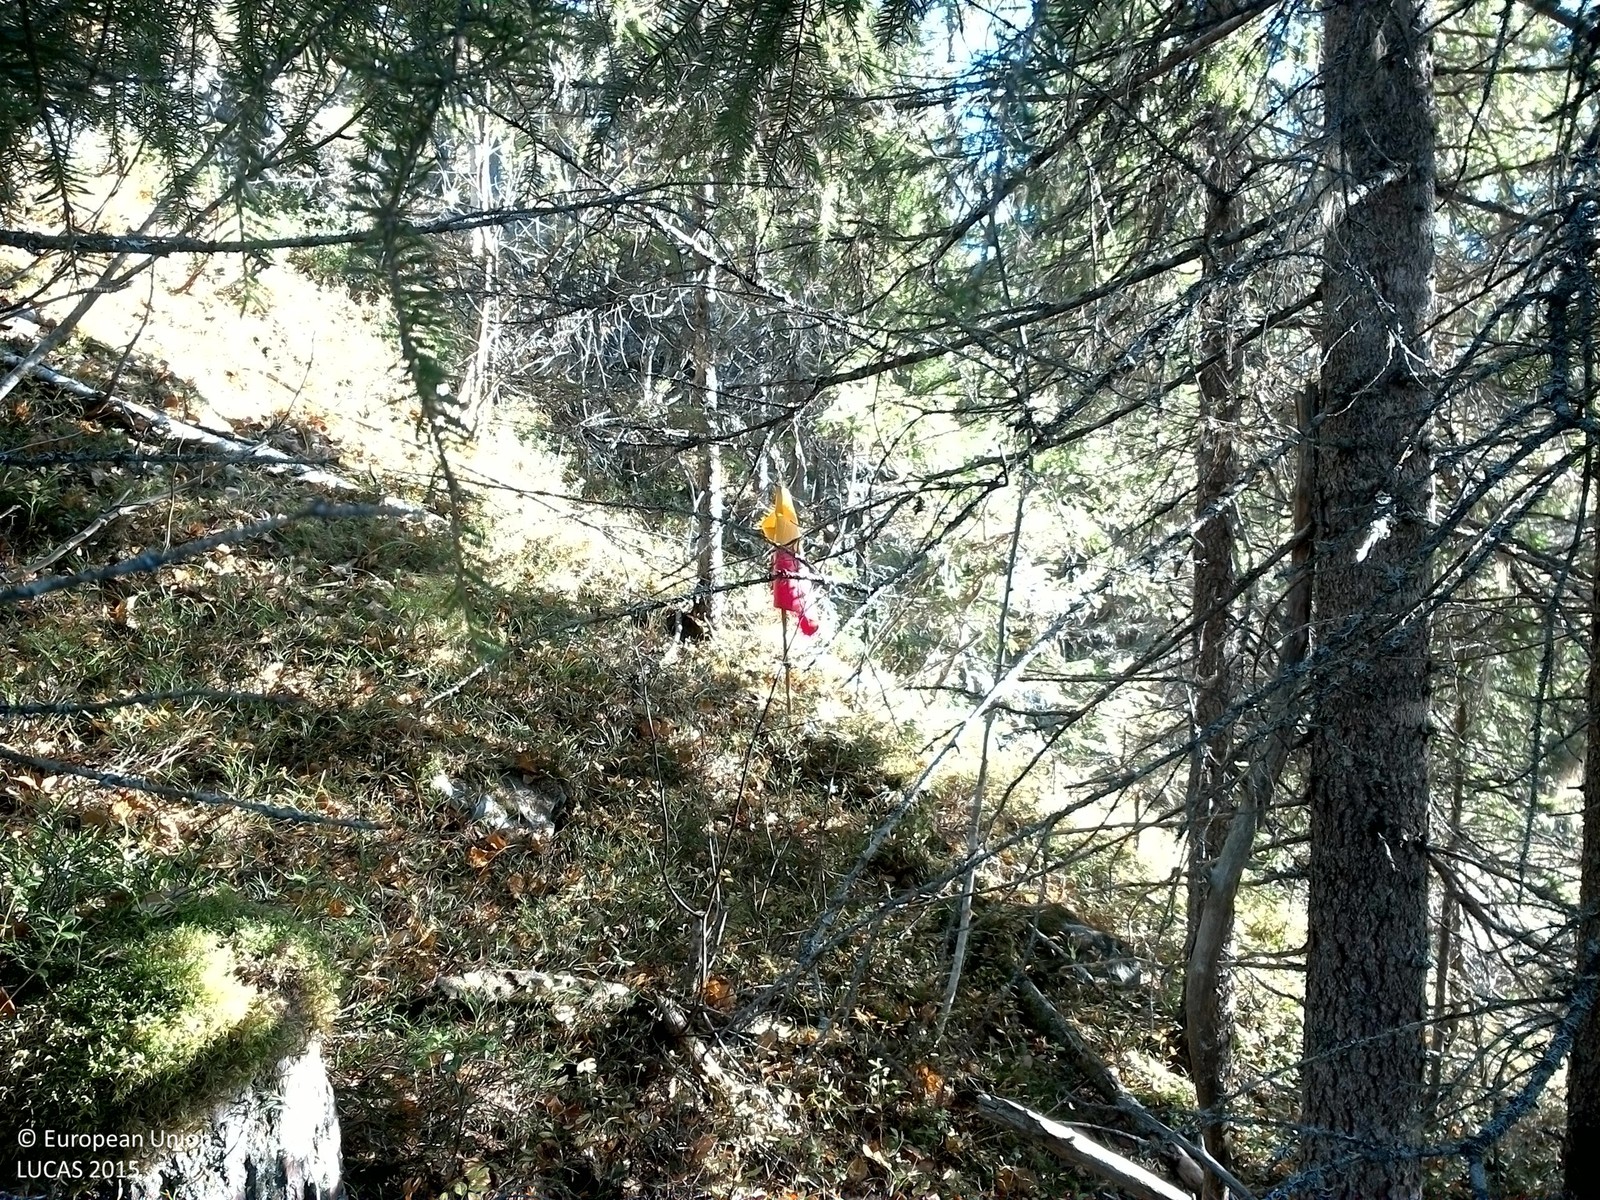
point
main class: Woodland
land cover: Spruce dominated mixed woodland
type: boreal forest
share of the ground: 25 - 50 %
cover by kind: coniferous forest trees 30 %, shrubs 30 %, lichens and mosses 20 %, broadleaved forest trees 10 %, consolidated bare surface 10 %
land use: Forestry
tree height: > 5 m
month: October
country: SE
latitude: 64.5052
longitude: 15.4050
